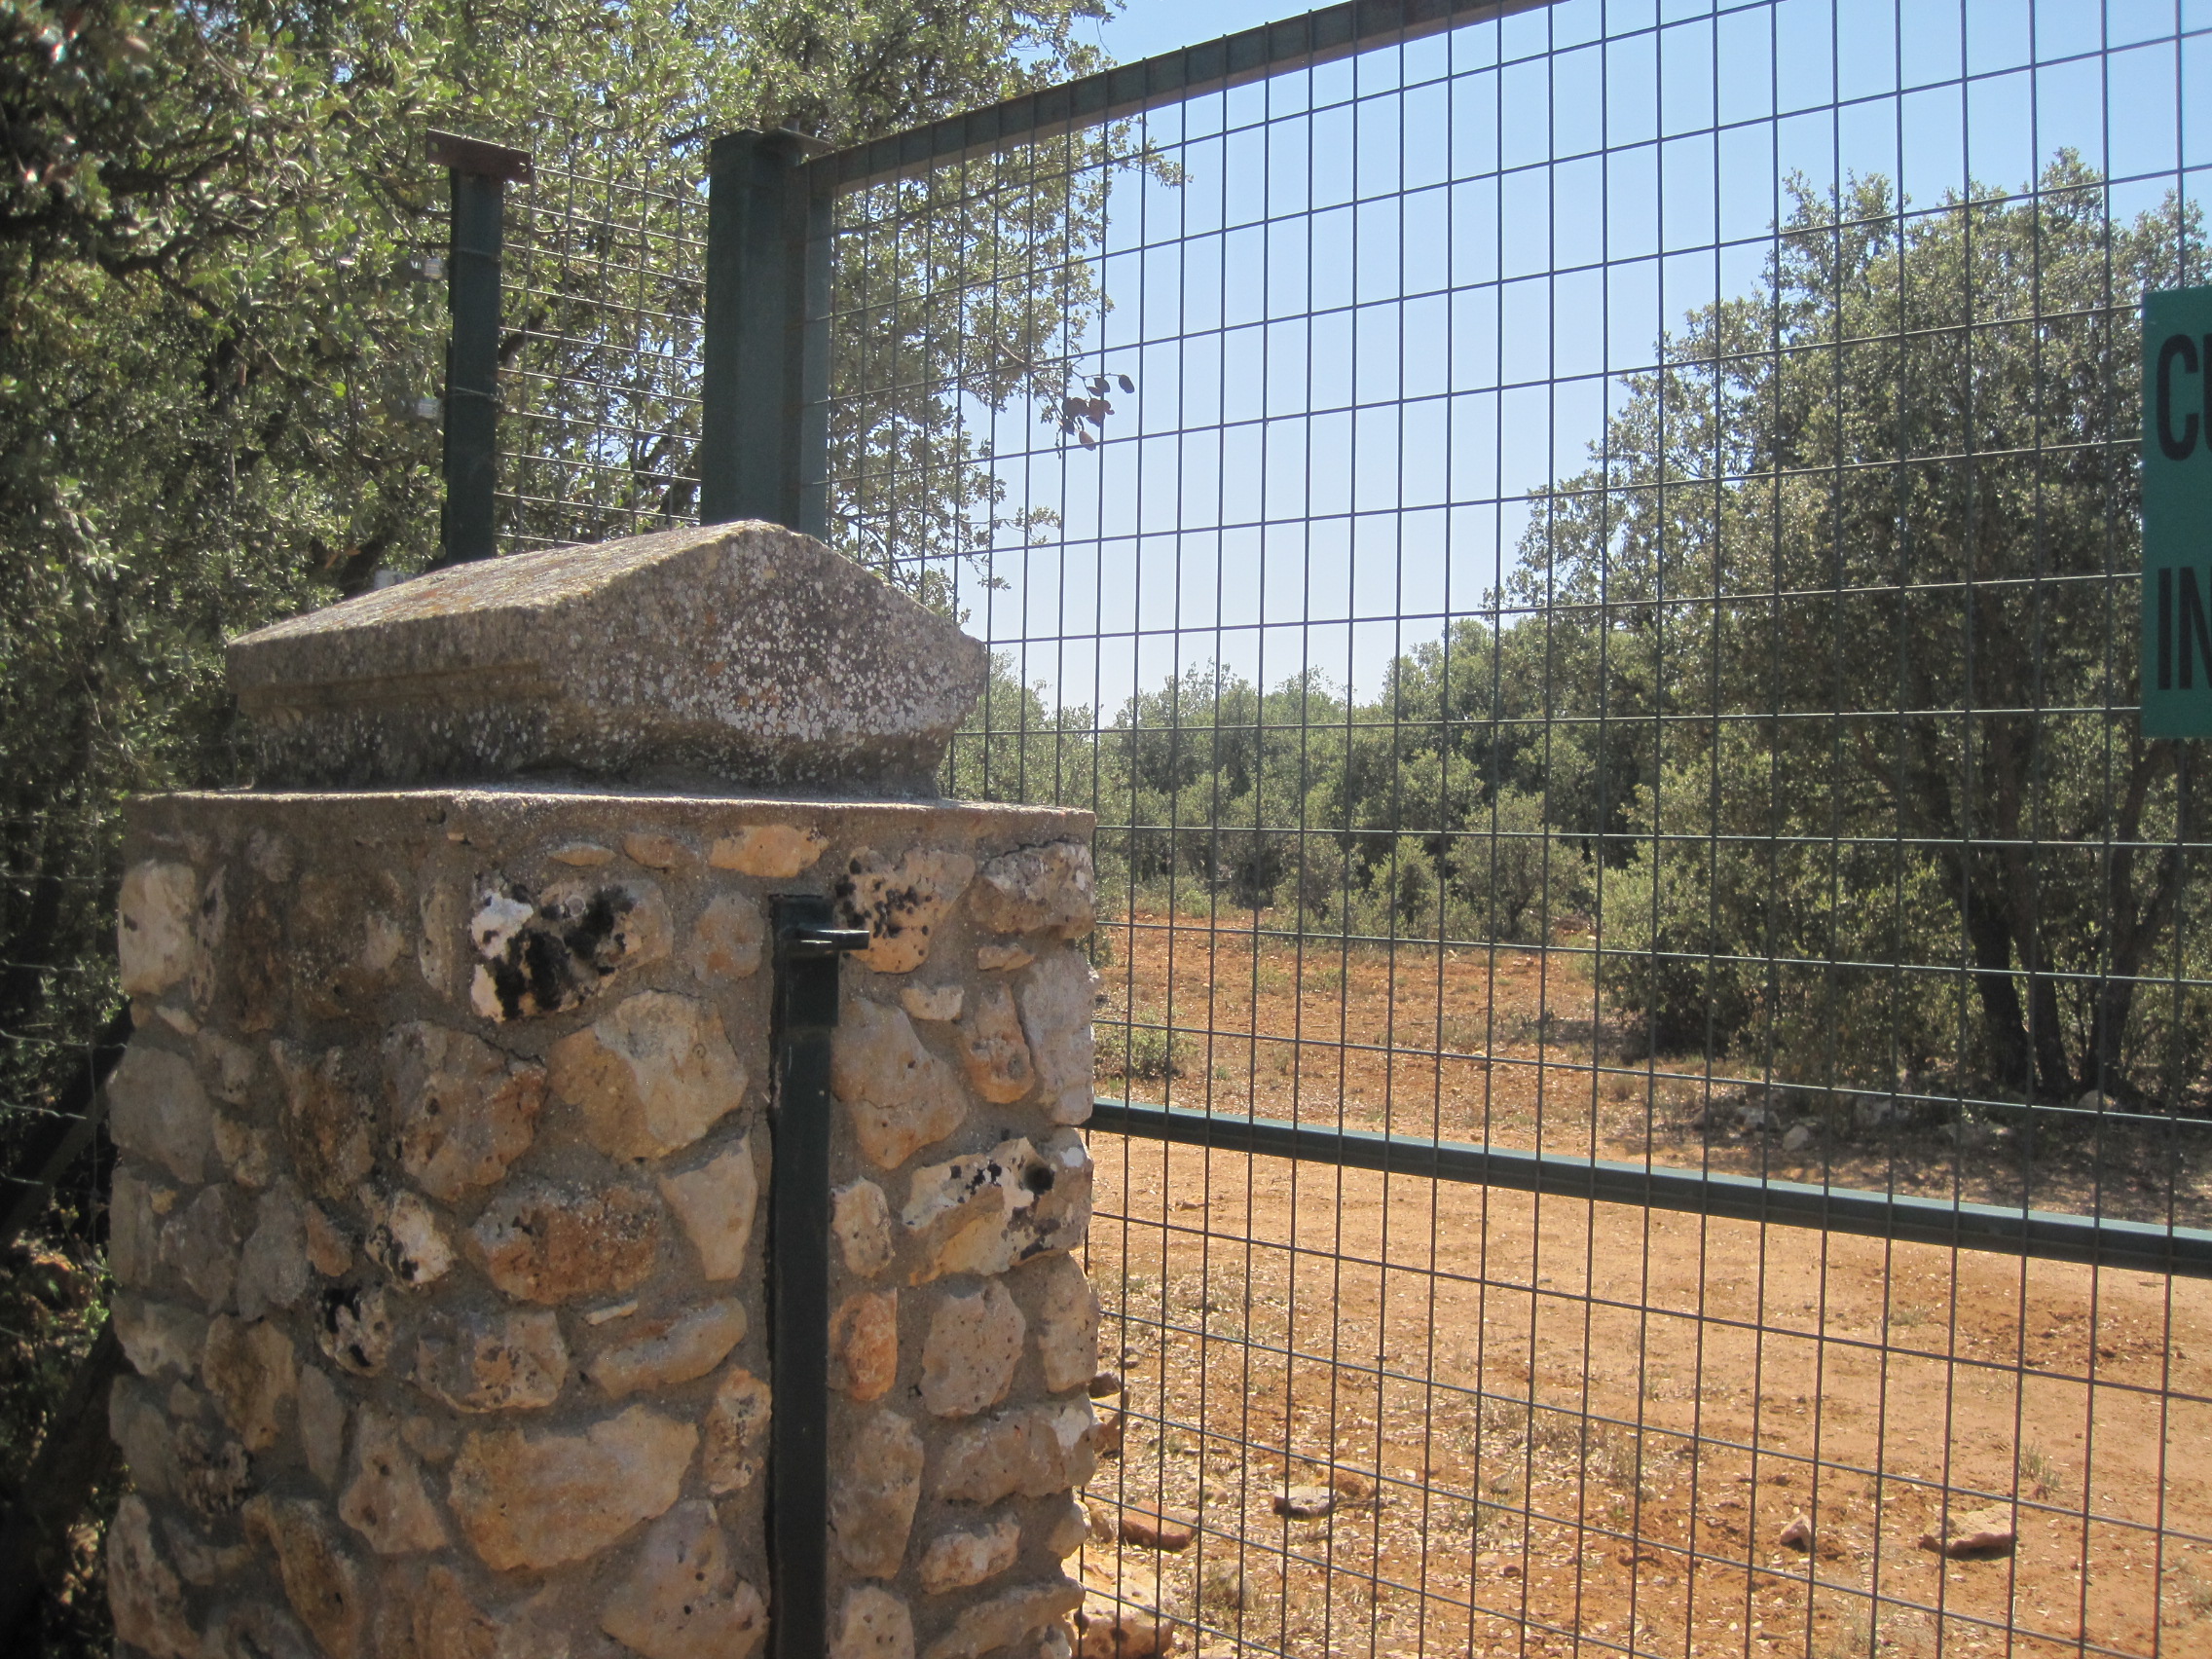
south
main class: Woodland
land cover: Broadleaved woodland
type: thermophilous deciduous forest
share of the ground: > 75 %
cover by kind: broadleaved forest trees 80 %, herbaceous plants 20 %
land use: Forestry
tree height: > 5 m
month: July
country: ES
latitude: 41.7460
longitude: -5.1454
